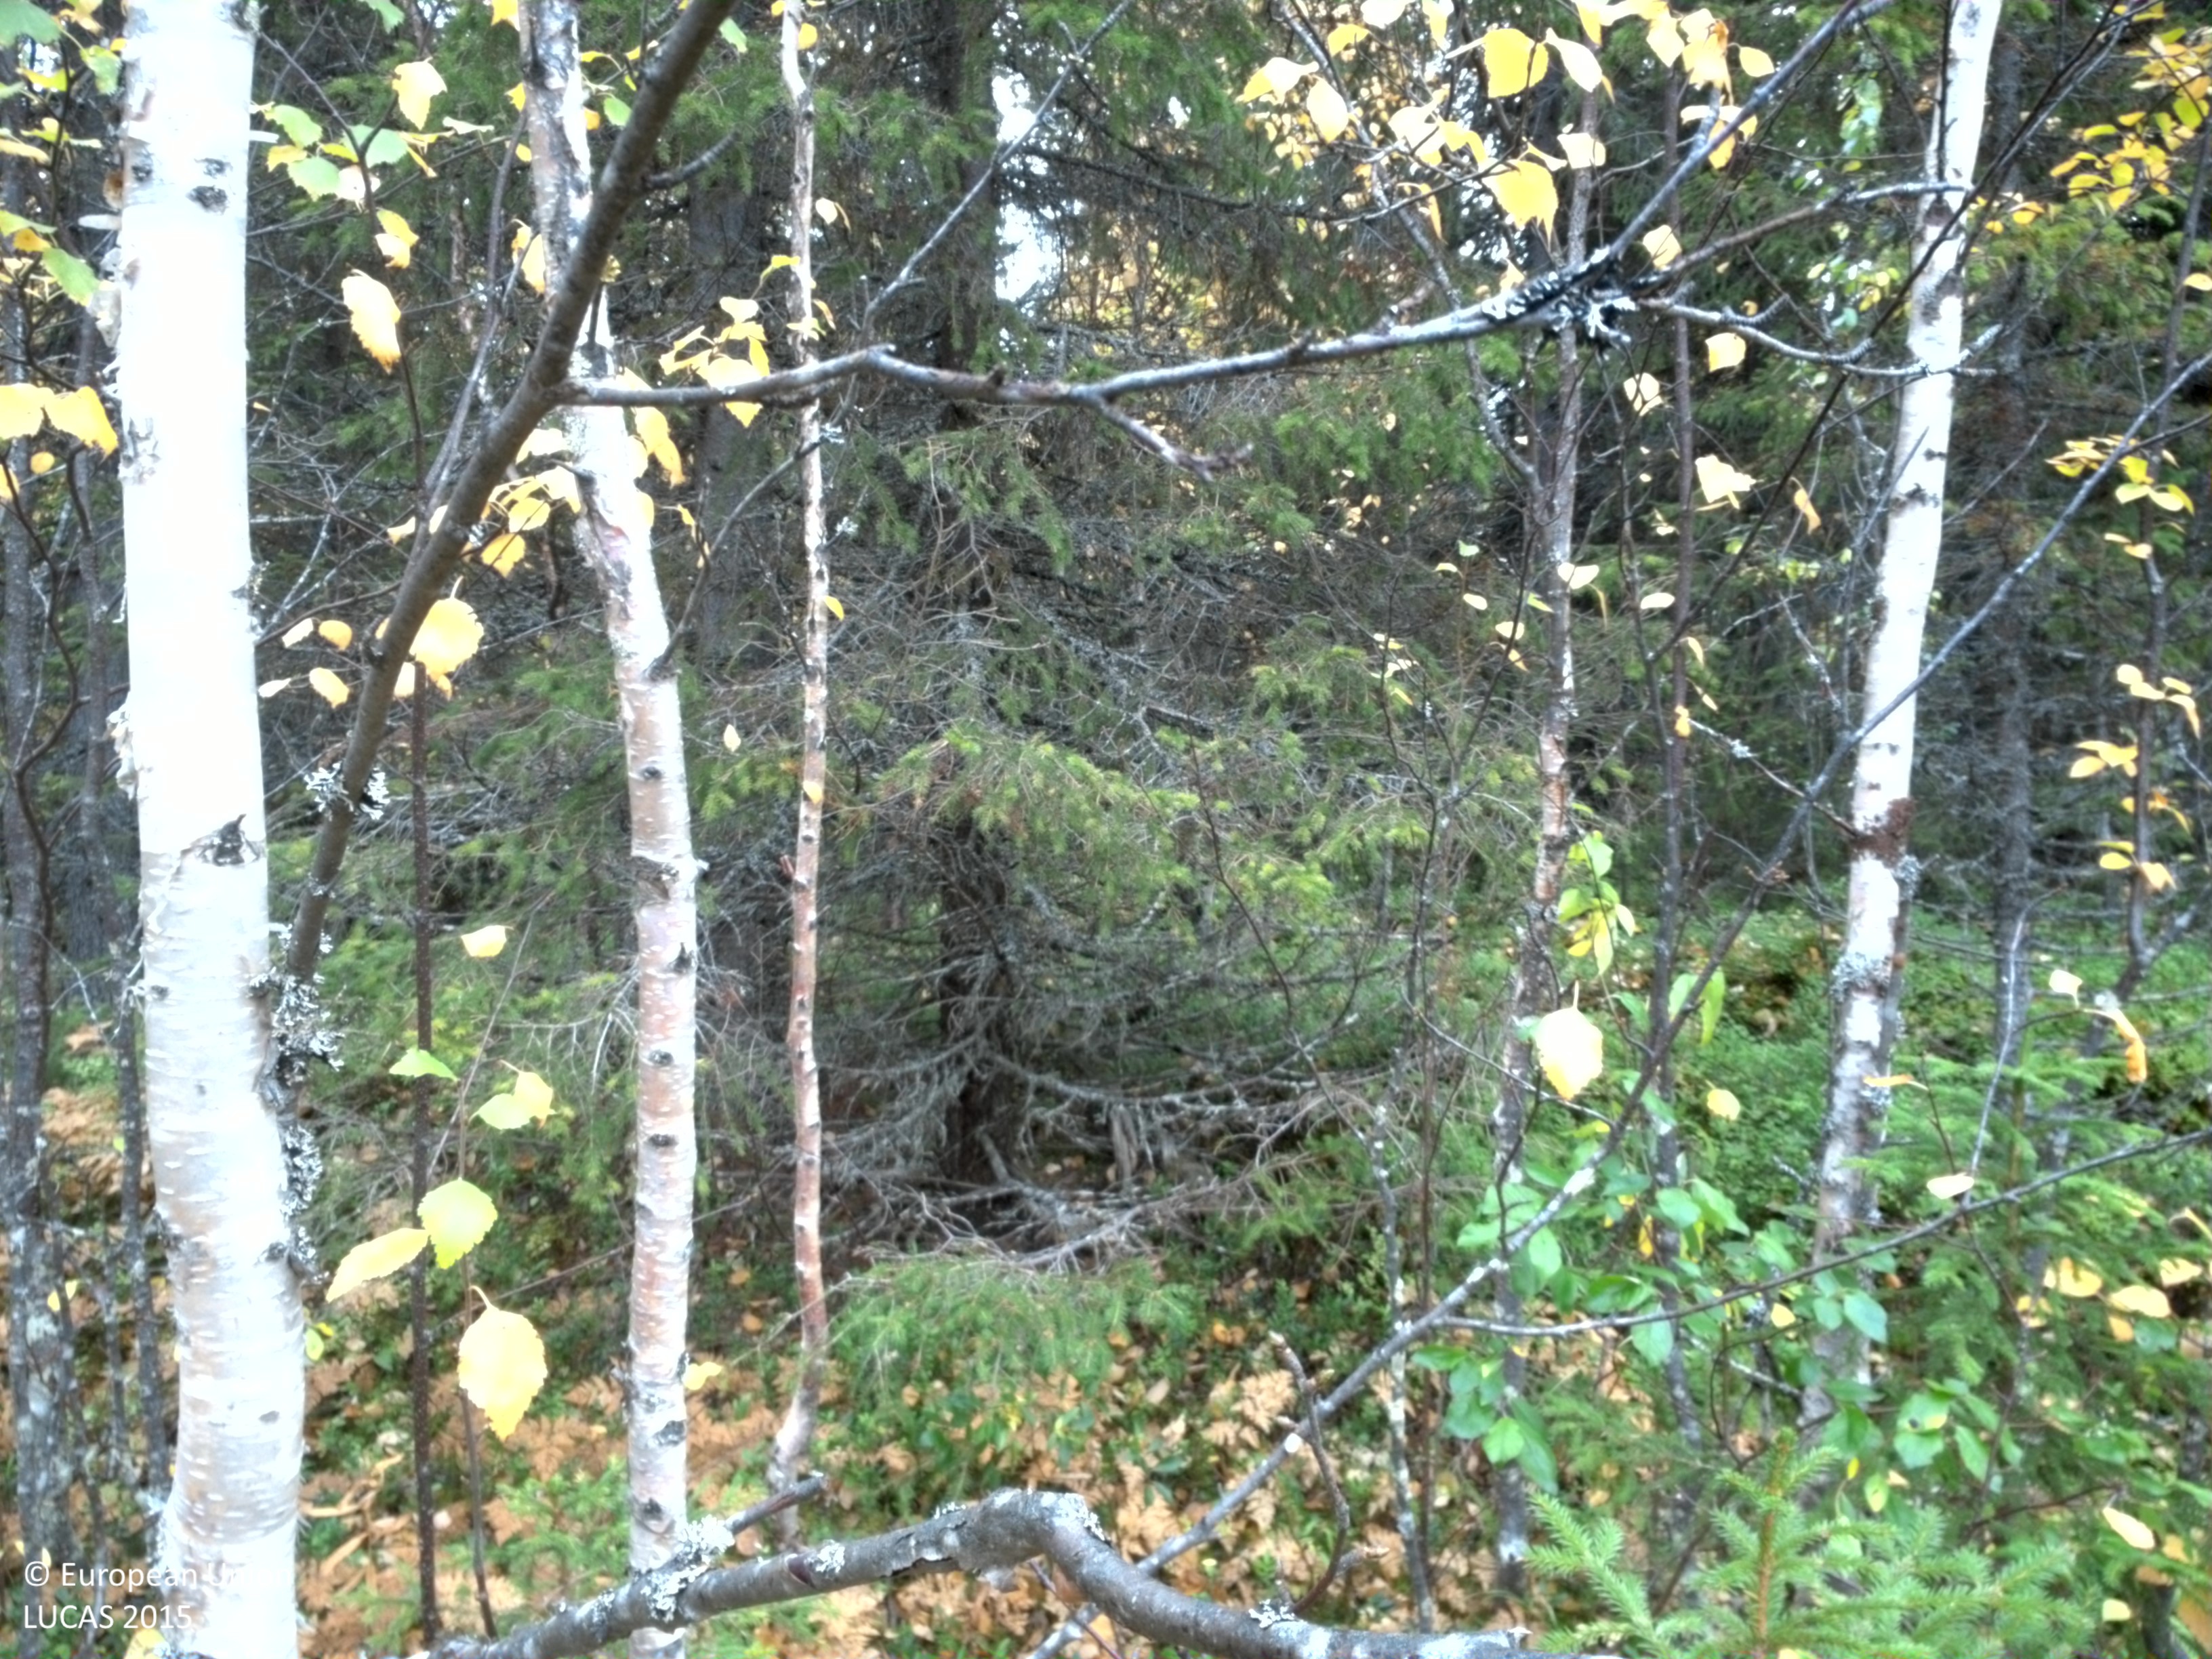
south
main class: Woodland
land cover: Broadleaved woodland
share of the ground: 50 - 75 %
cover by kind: broadleaved forest trees 50 %, shrubs 25 %, herbaceous plants 10 %, lichens and mosses 10 %, coniferous forest trees 5 %
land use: Forestry
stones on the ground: < 10 %
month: September
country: SE
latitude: 65.3606
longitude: 16.3044
